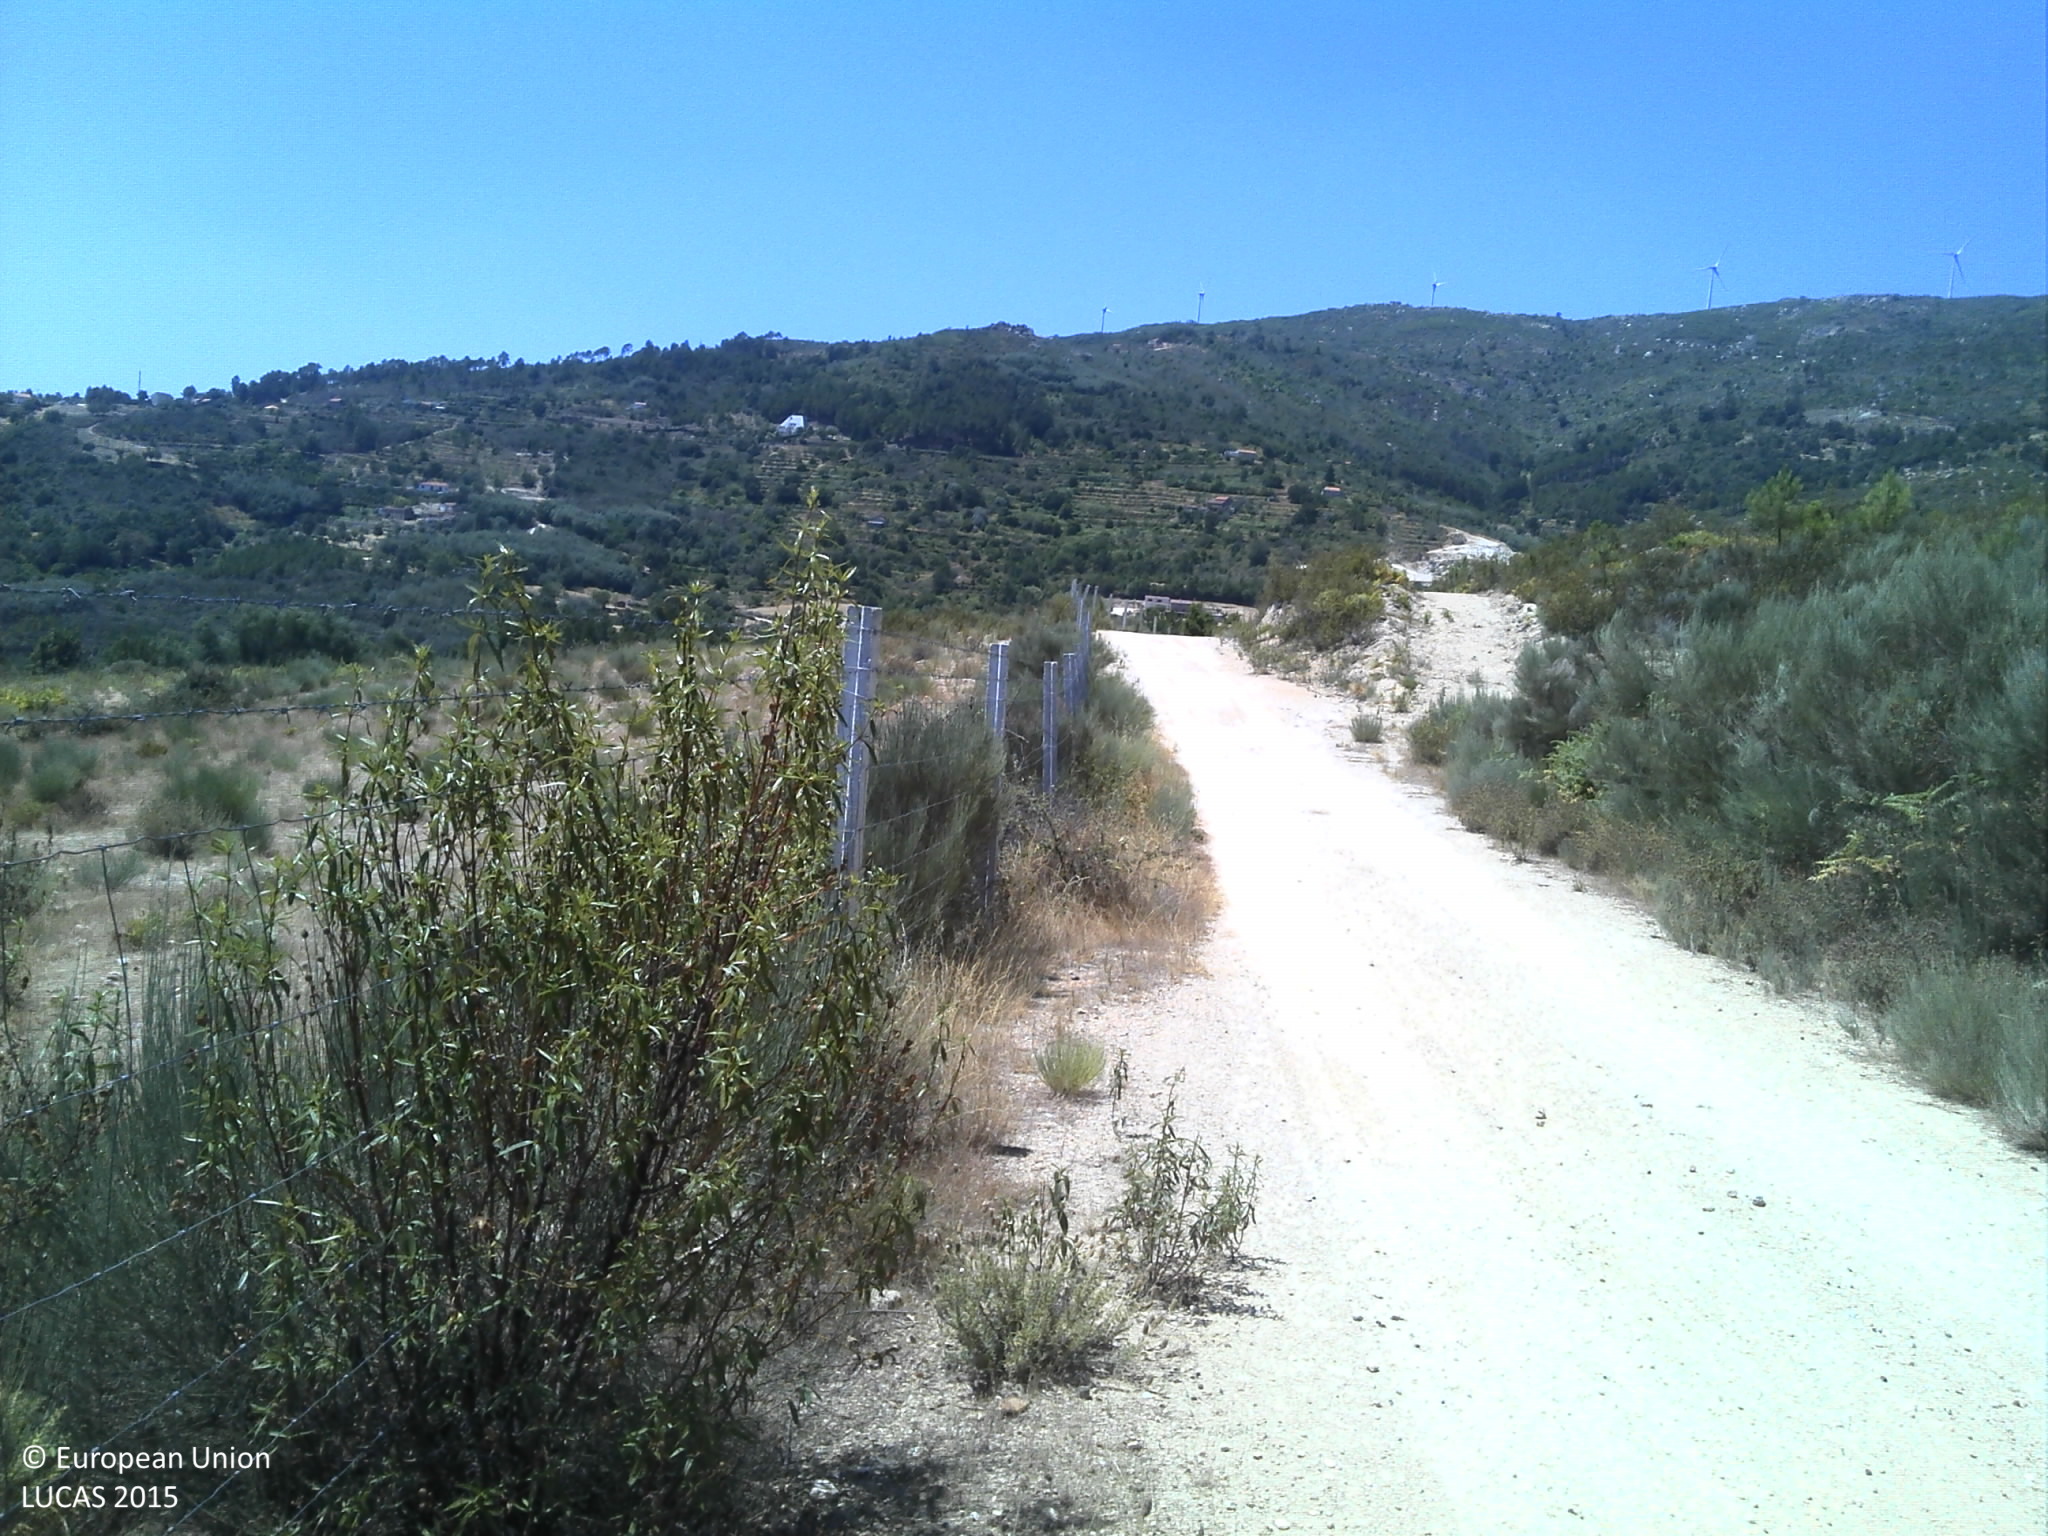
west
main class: Woodland
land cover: Broadleaved woodland
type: broadleaved evergreen forest
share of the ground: 10 - 25 %
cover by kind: herbaceous plants 40 %, unconsolidated bare surface 40 %, broadleaved forest trees 20 %
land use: Forestry
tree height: < 5 m
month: July
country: PT
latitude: 40.4282
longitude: -7.3266
